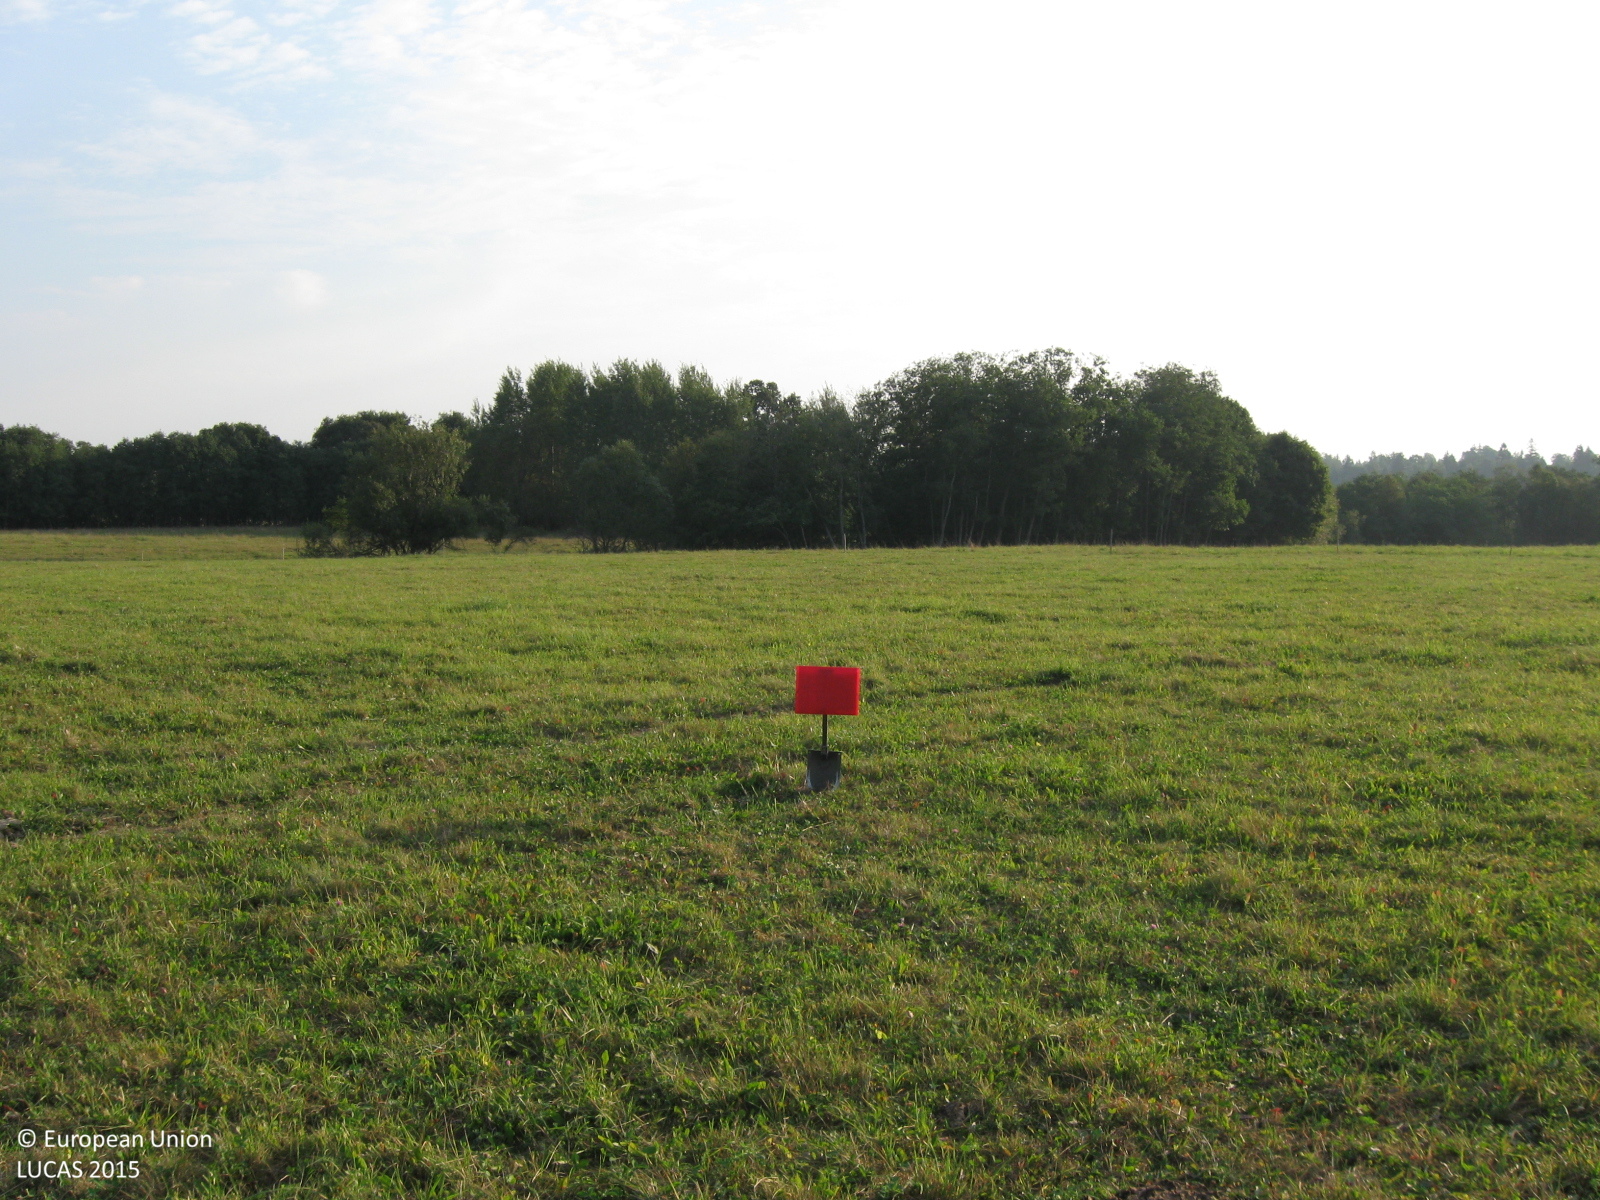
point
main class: Grassland
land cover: Grassland without tree/shrub cover
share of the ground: > 75 %
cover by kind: herbaceous plants 100 %
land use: Agriculture (excluding fallow land and kitchen gardens)
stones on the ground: < 10 %
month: August
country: LT
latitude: 55.5393
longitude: 23.0164
